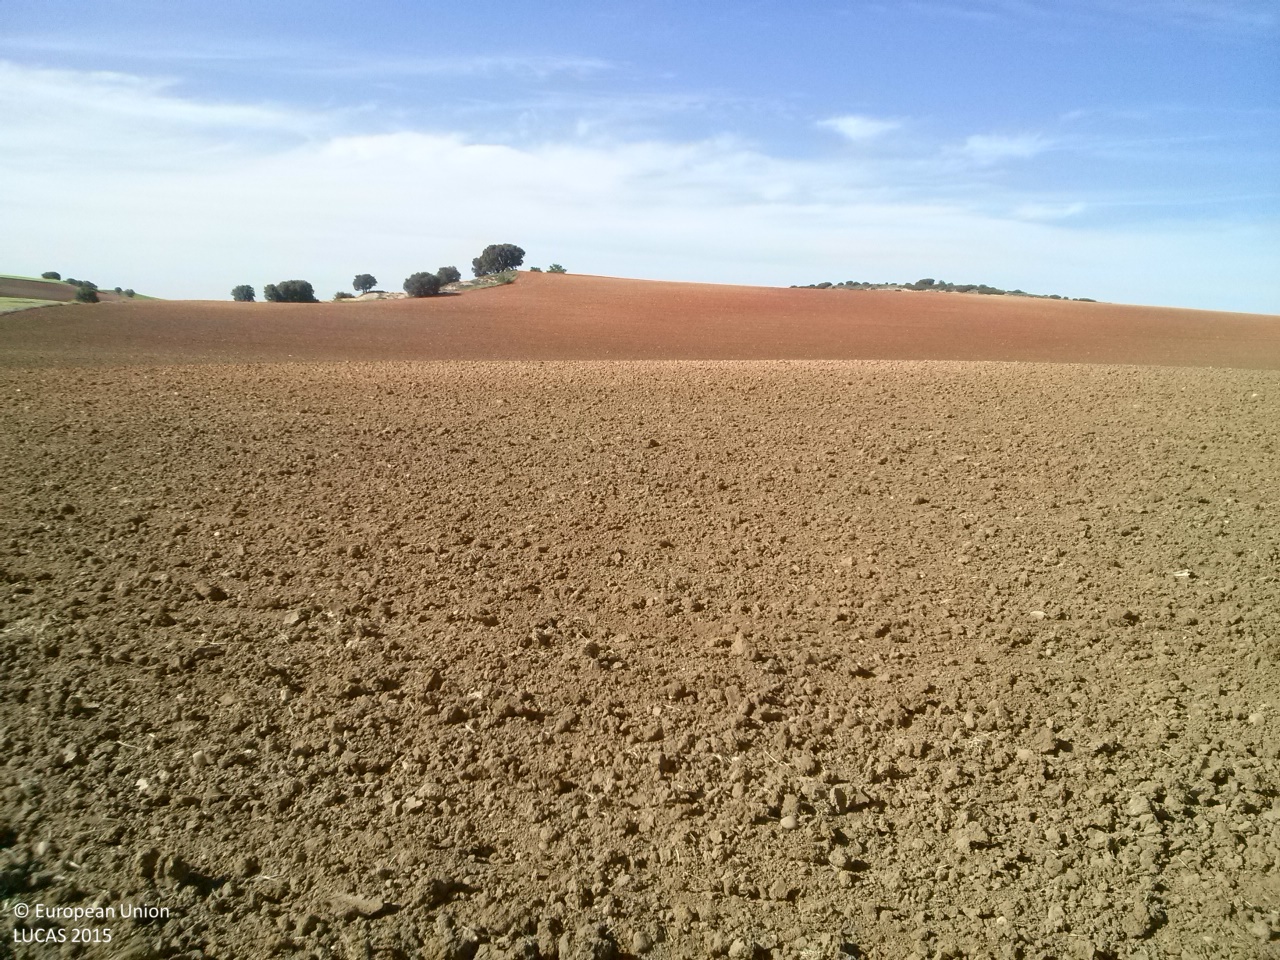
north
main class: Cropland
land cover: Sunflower
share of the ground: < 10 %
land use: Agriculture (excluding fallow land and kitchen gardens)
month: May
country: ES
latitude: 39.8528
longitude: -2.7475
